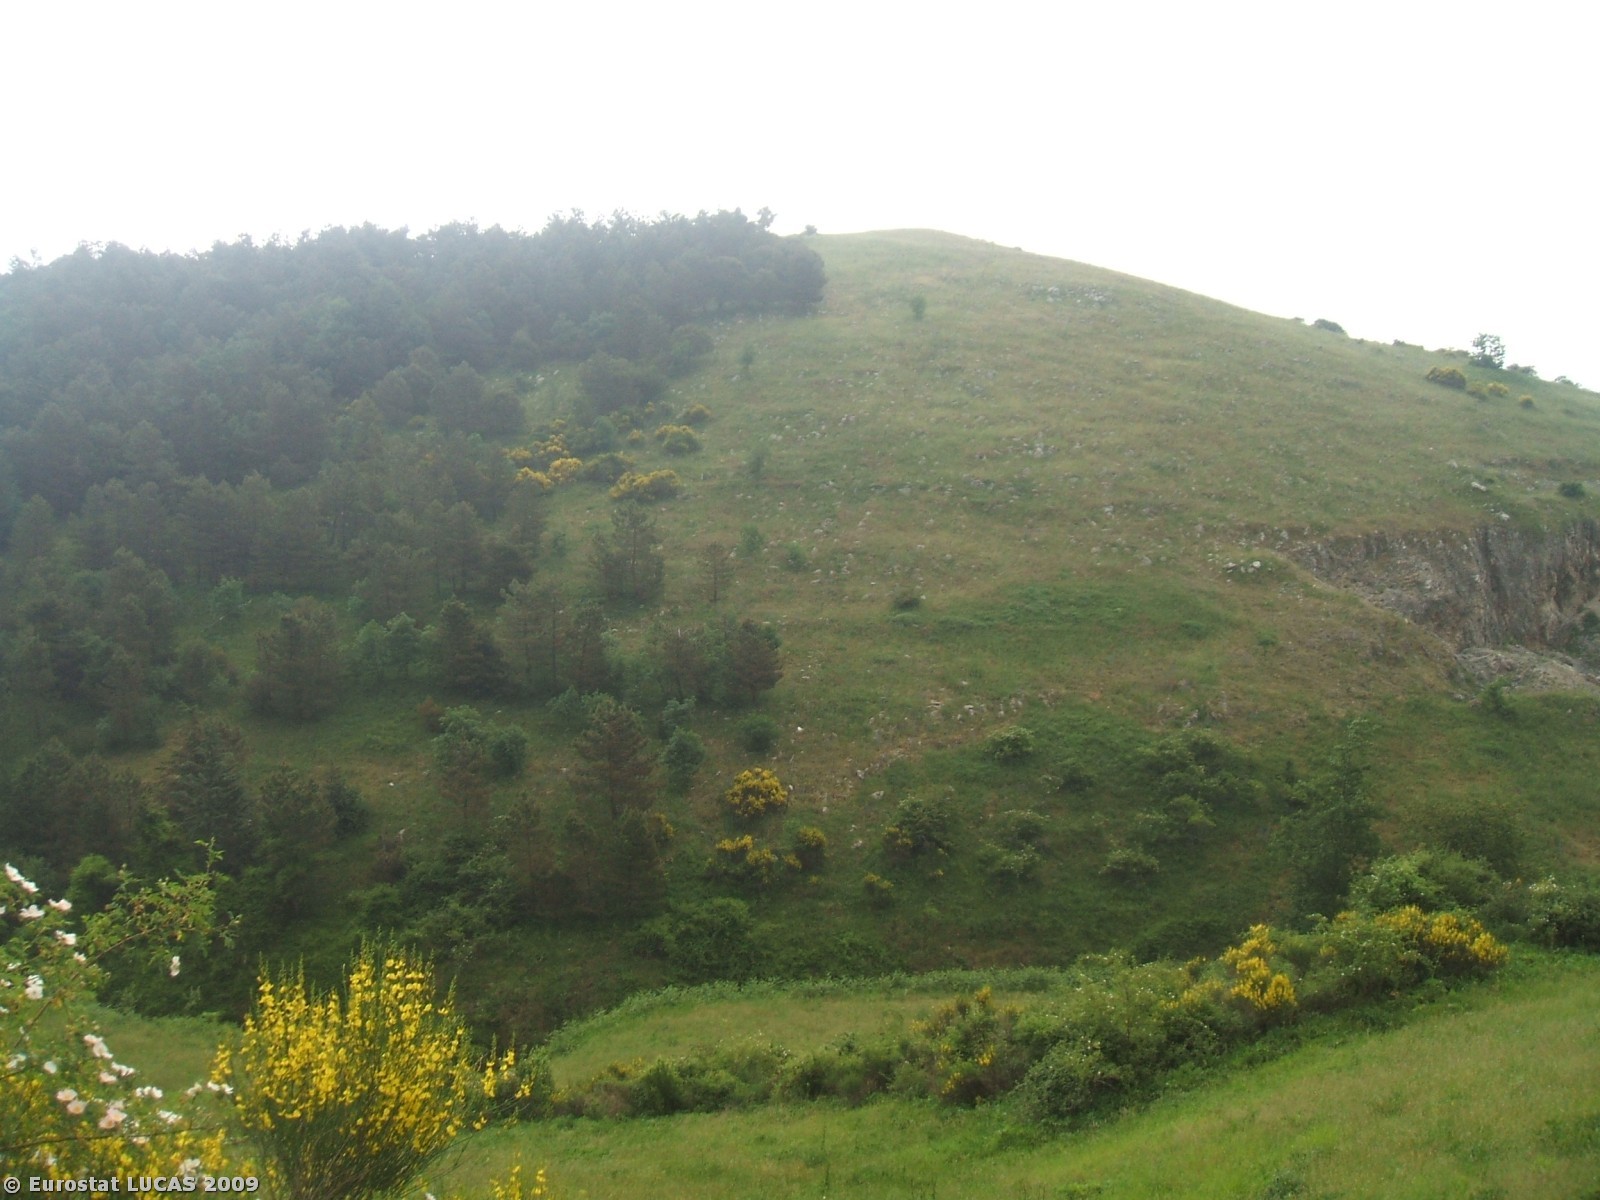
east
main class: Shrubland
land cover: Shrubland without tree cover
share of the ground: > 75 %
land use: Fallow land
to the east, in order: Shrubland without tree cover; Grassland without tree/shrub cover; Shrubland without tree cover; Grassland without tree/shrub cover; Shrubland without tree cover; Grass margins; Paved roads, cycling and walking lanes; Mixed woodland
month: May
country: IT
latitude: 40.4879
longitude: 15.6047
